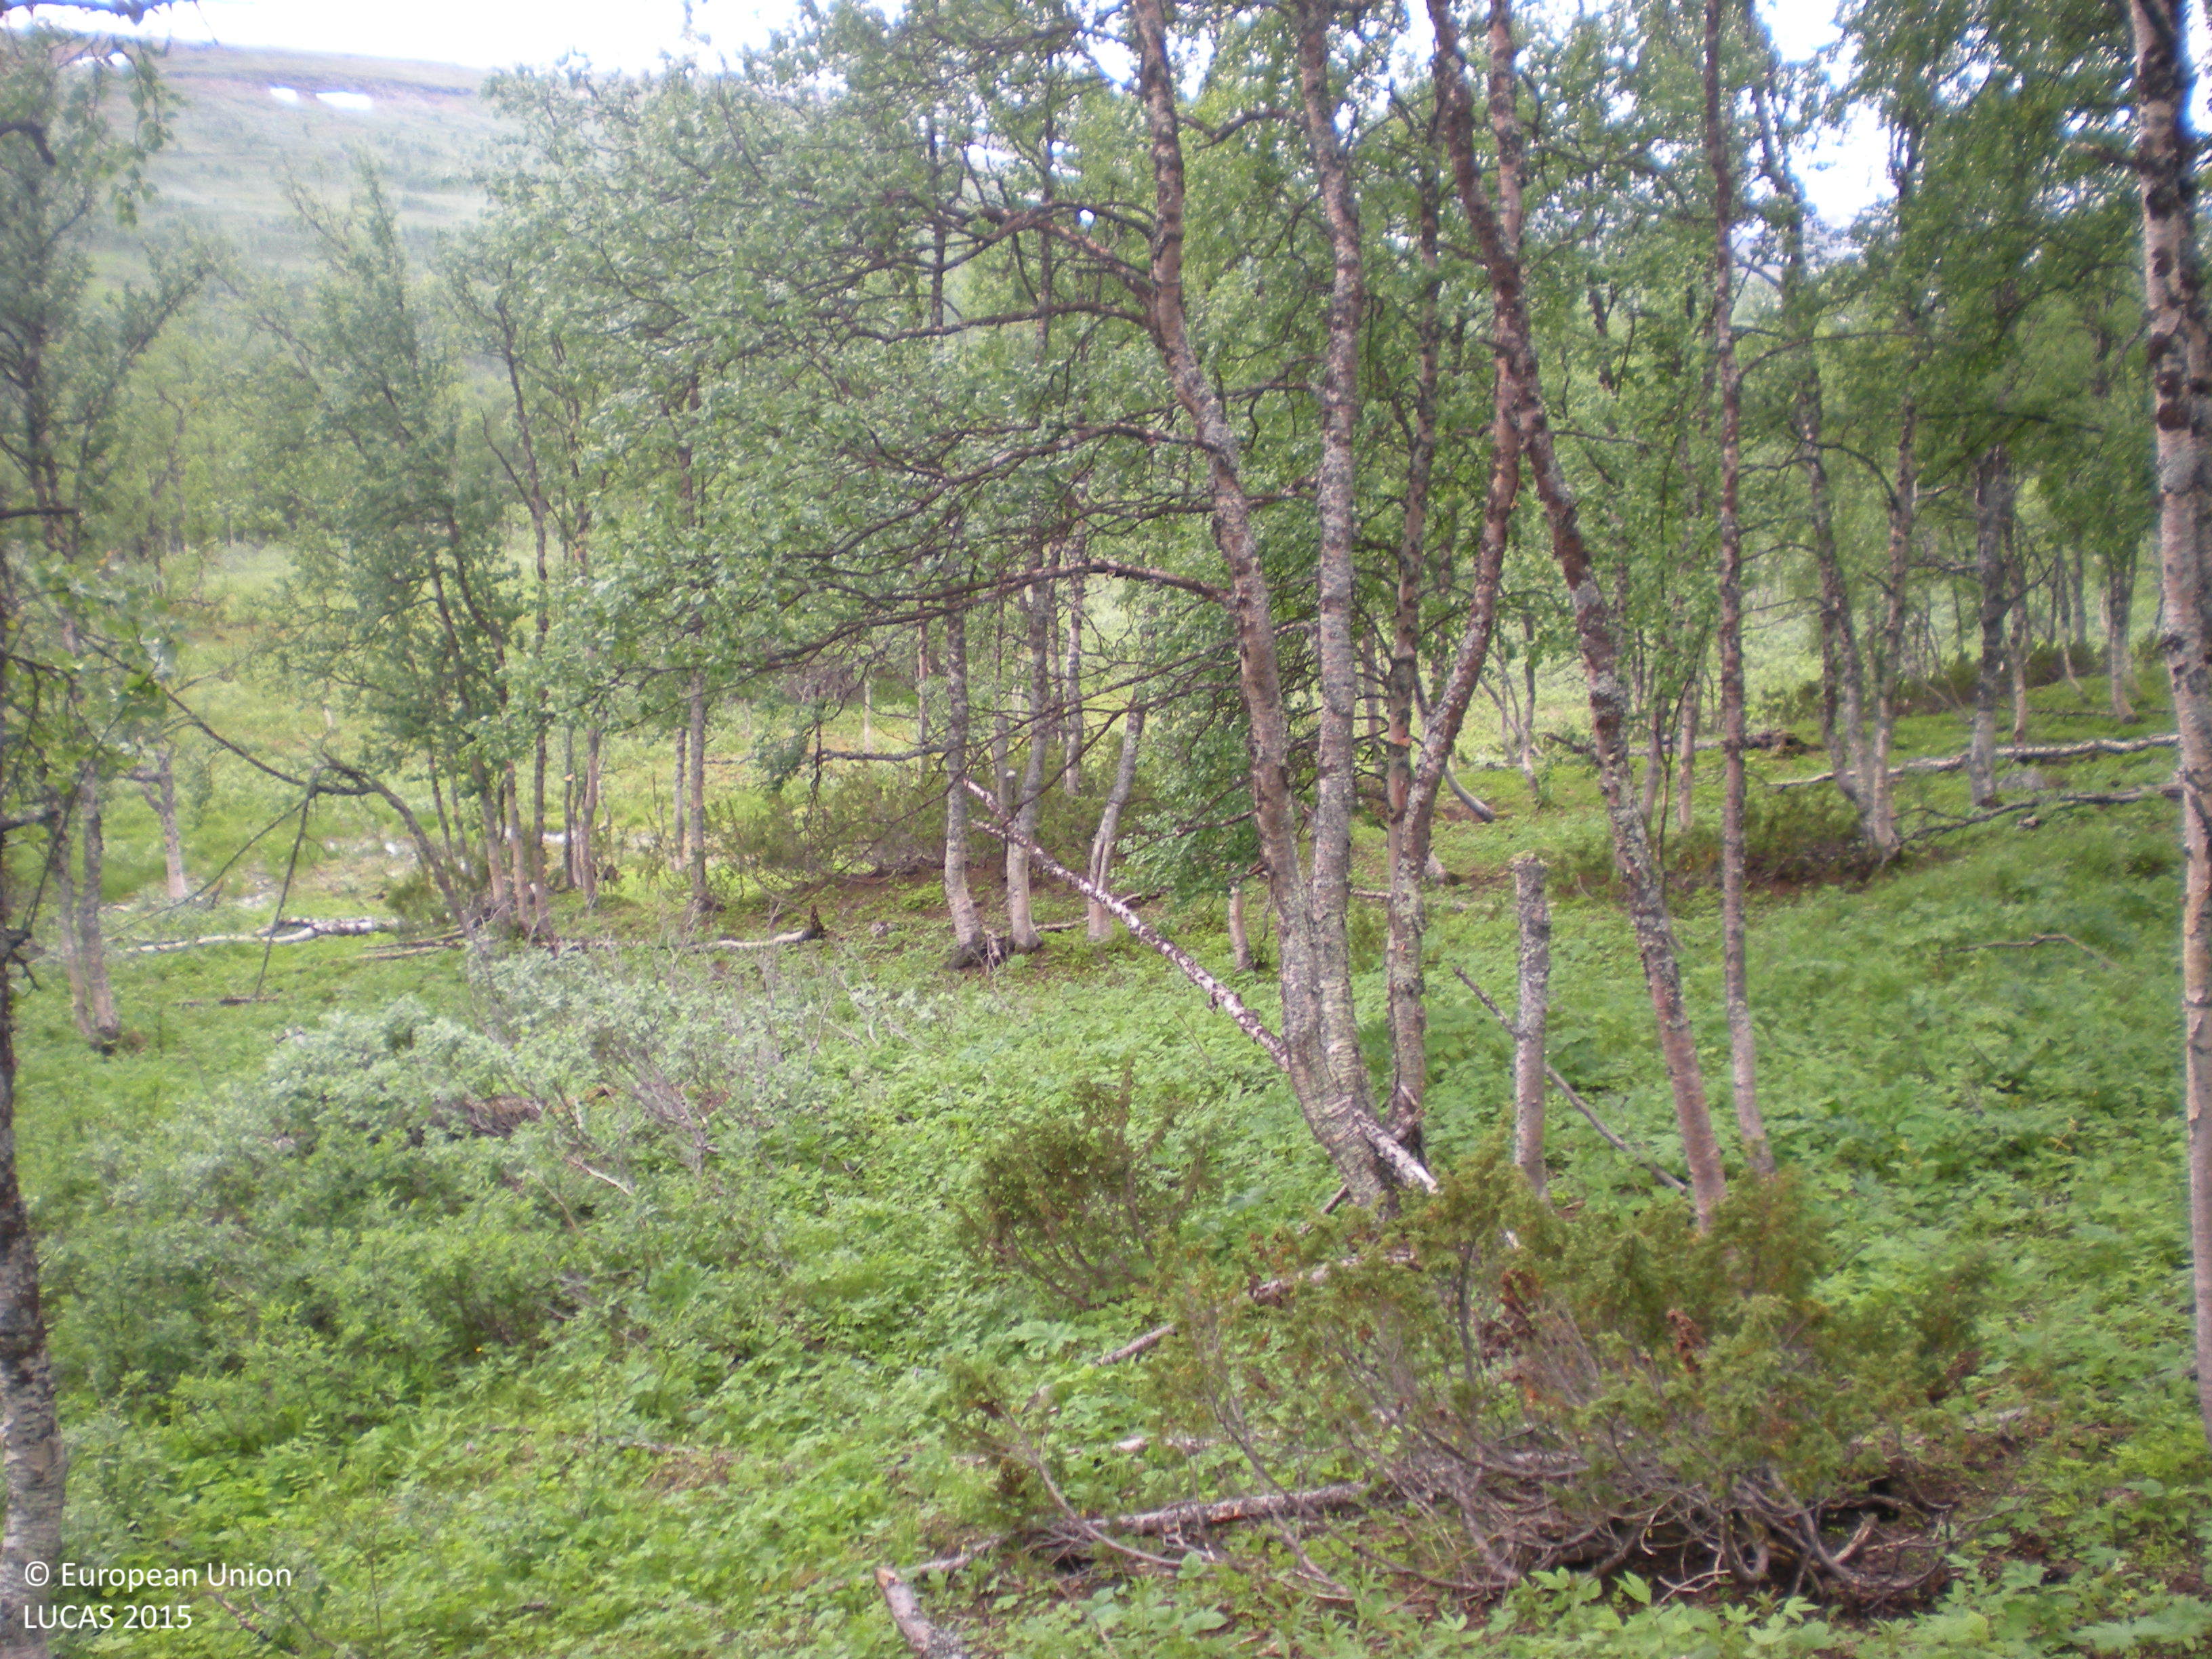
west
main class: Woodland
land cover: Broadleaved woodland
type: boreal forest
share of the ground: 50 - 75 %
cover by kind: broadleaved forest trees 55 %, herbaceous plants 30 %, shrubs 15 %
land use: Semi-natural and natural areas not in use
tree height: > 5 m
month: August
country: SE
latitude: 66.6737
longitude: 16.1332
